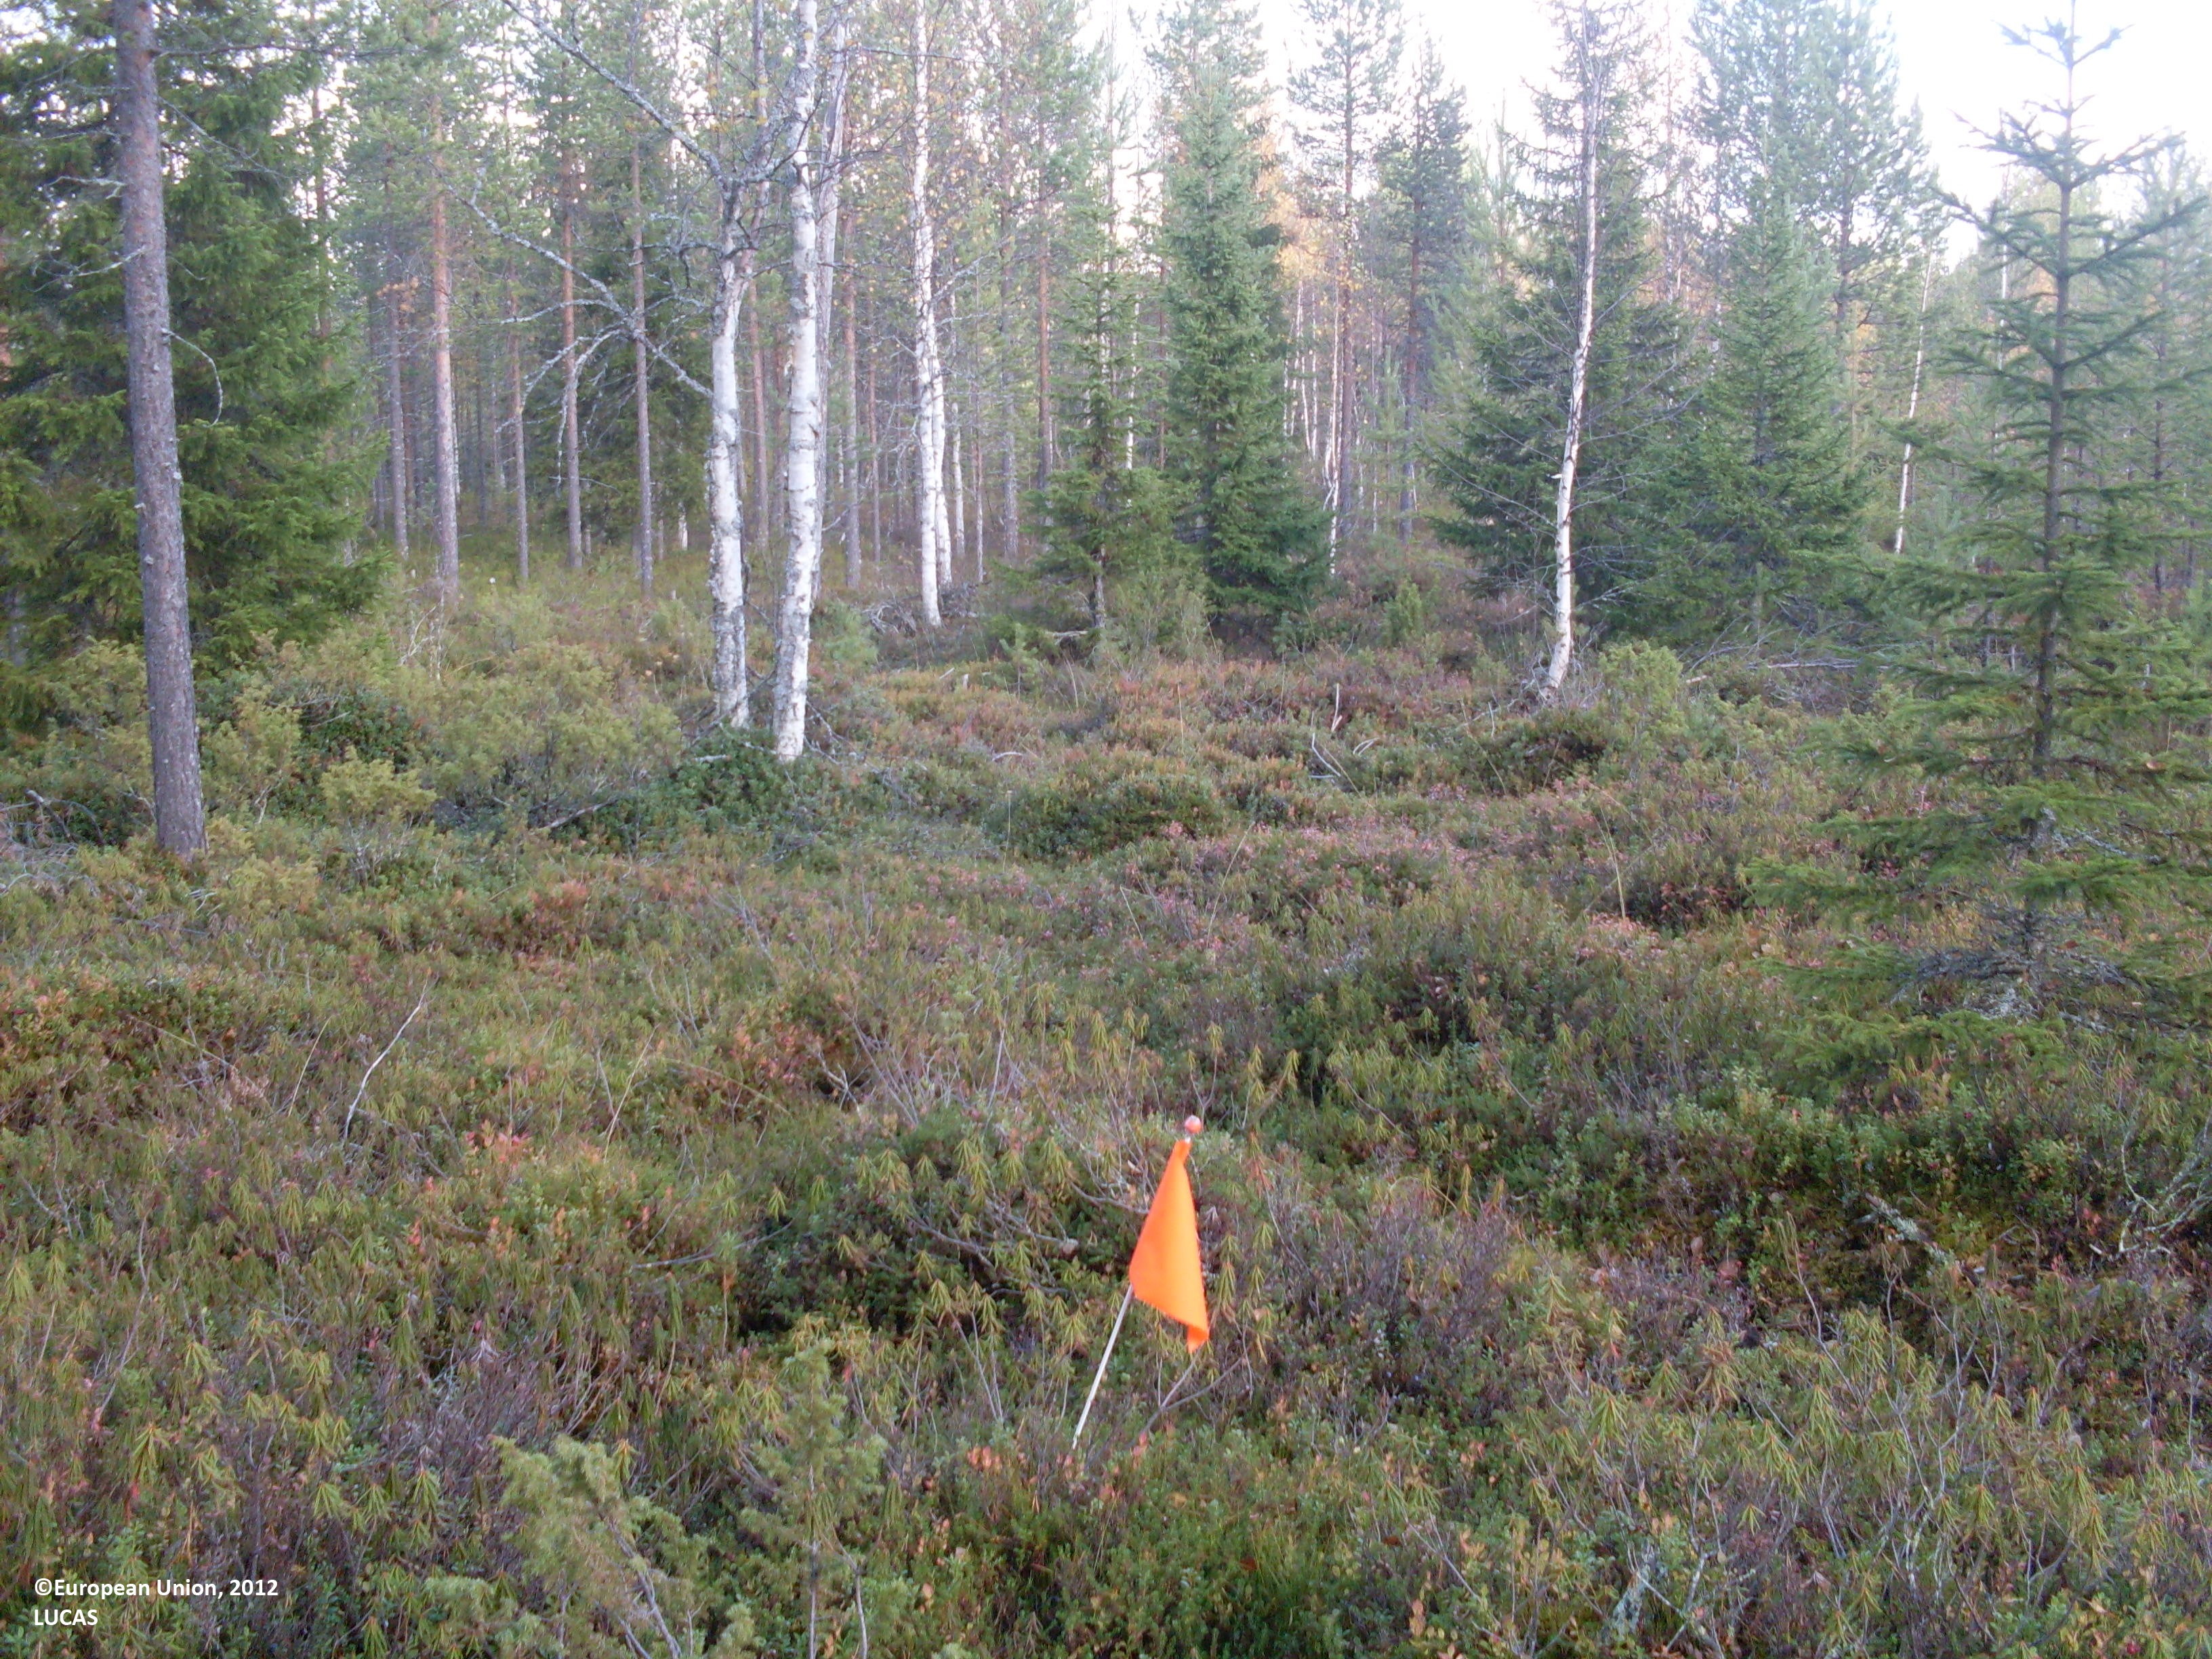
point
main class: Woodland
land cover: Pine dominated mixed woodland
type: boreal forest
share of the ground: 10 - 25 %
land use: Forestry
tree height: > 5 m
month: September
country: FI
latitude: 64.7512
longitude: 29.4326
